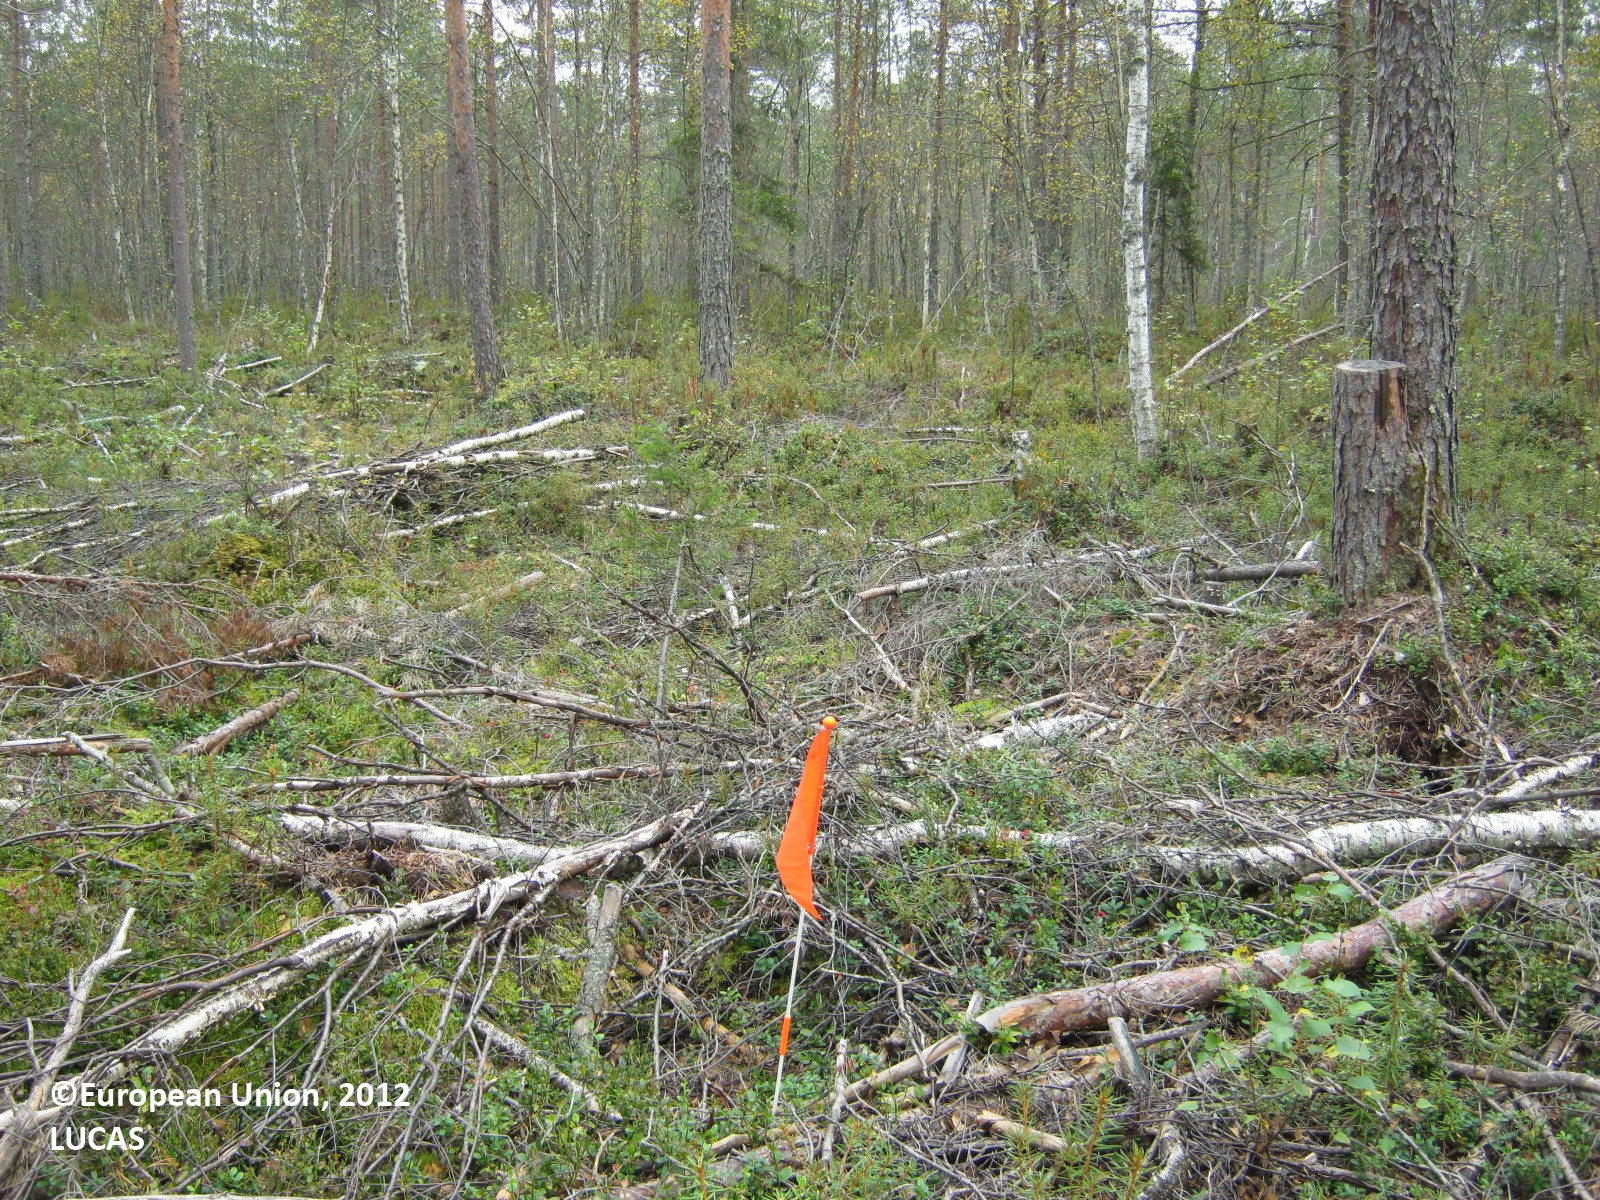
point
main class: Woodland
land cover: Pine dominated mixed woodland
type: boreal forest
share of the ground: 50 - 75 %
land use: Forestry
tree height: > 5 m
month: September
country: FI
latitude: 60.9965
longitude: 27.9656
